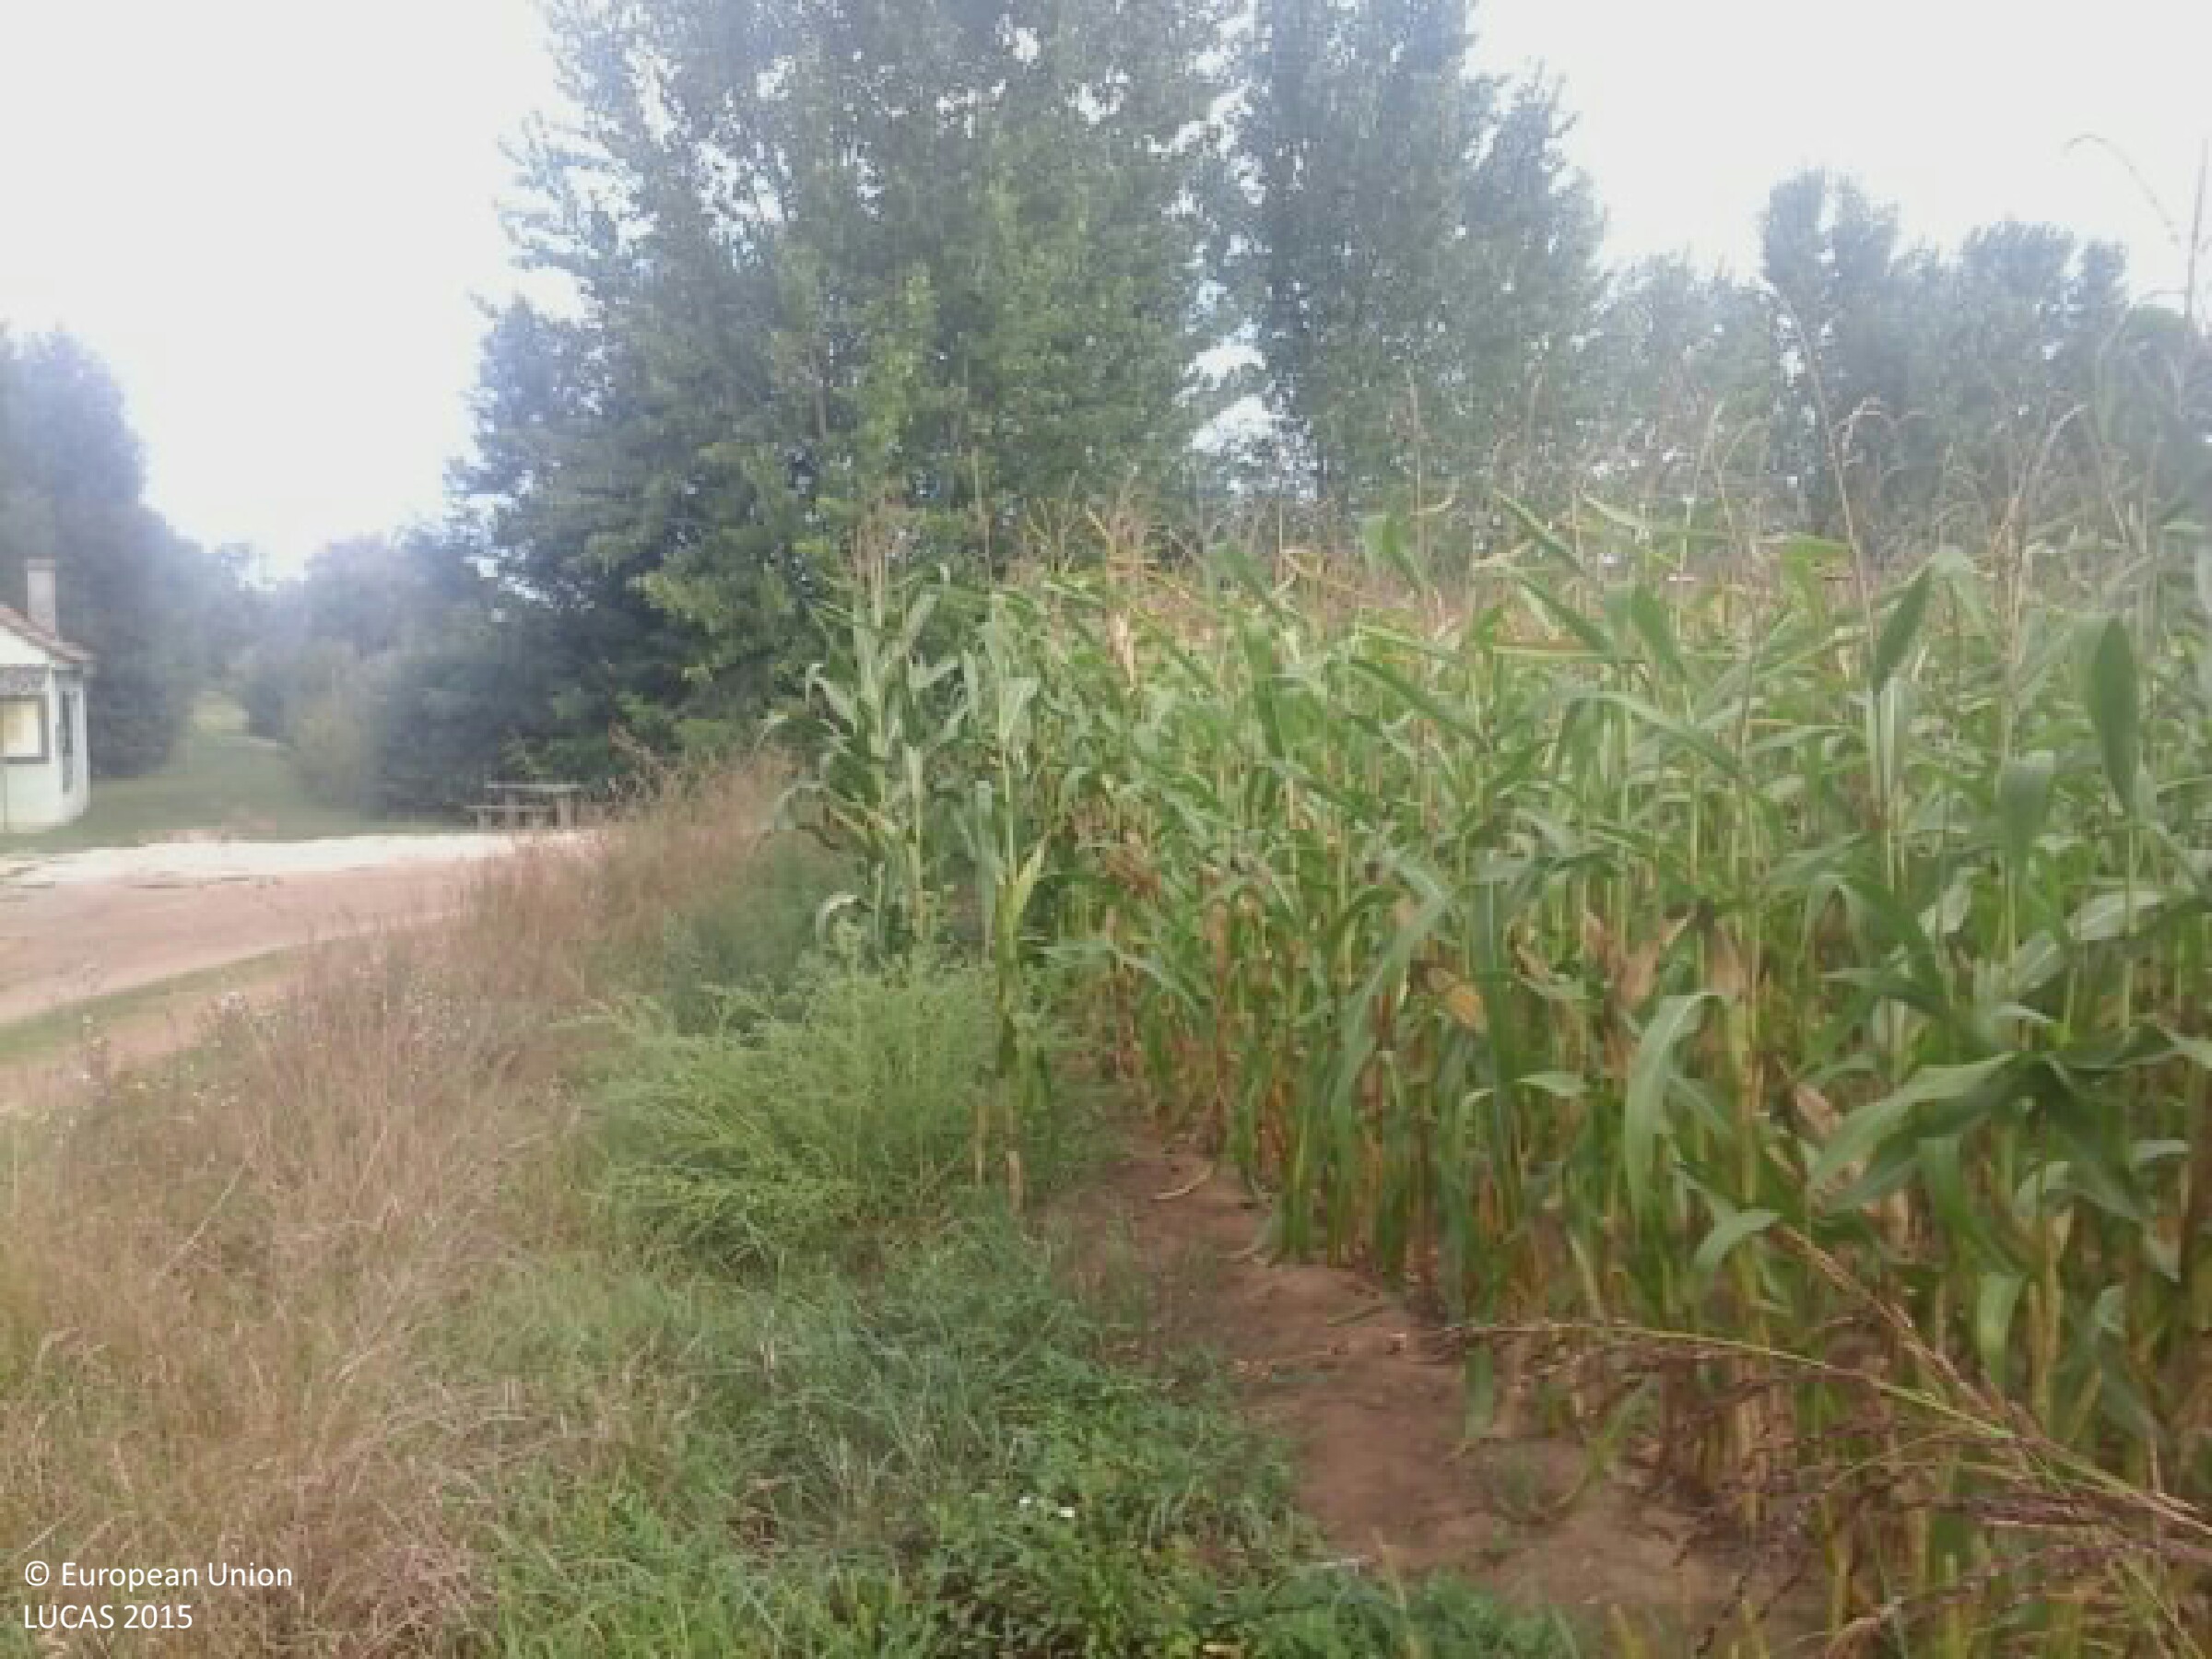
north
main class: Cropland
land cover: Maize
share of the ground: > 75 %
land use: Agriculture (excluding fallow land and kitchen gardens)
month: August
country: HU
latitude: 46.4354
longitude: 17.6974
